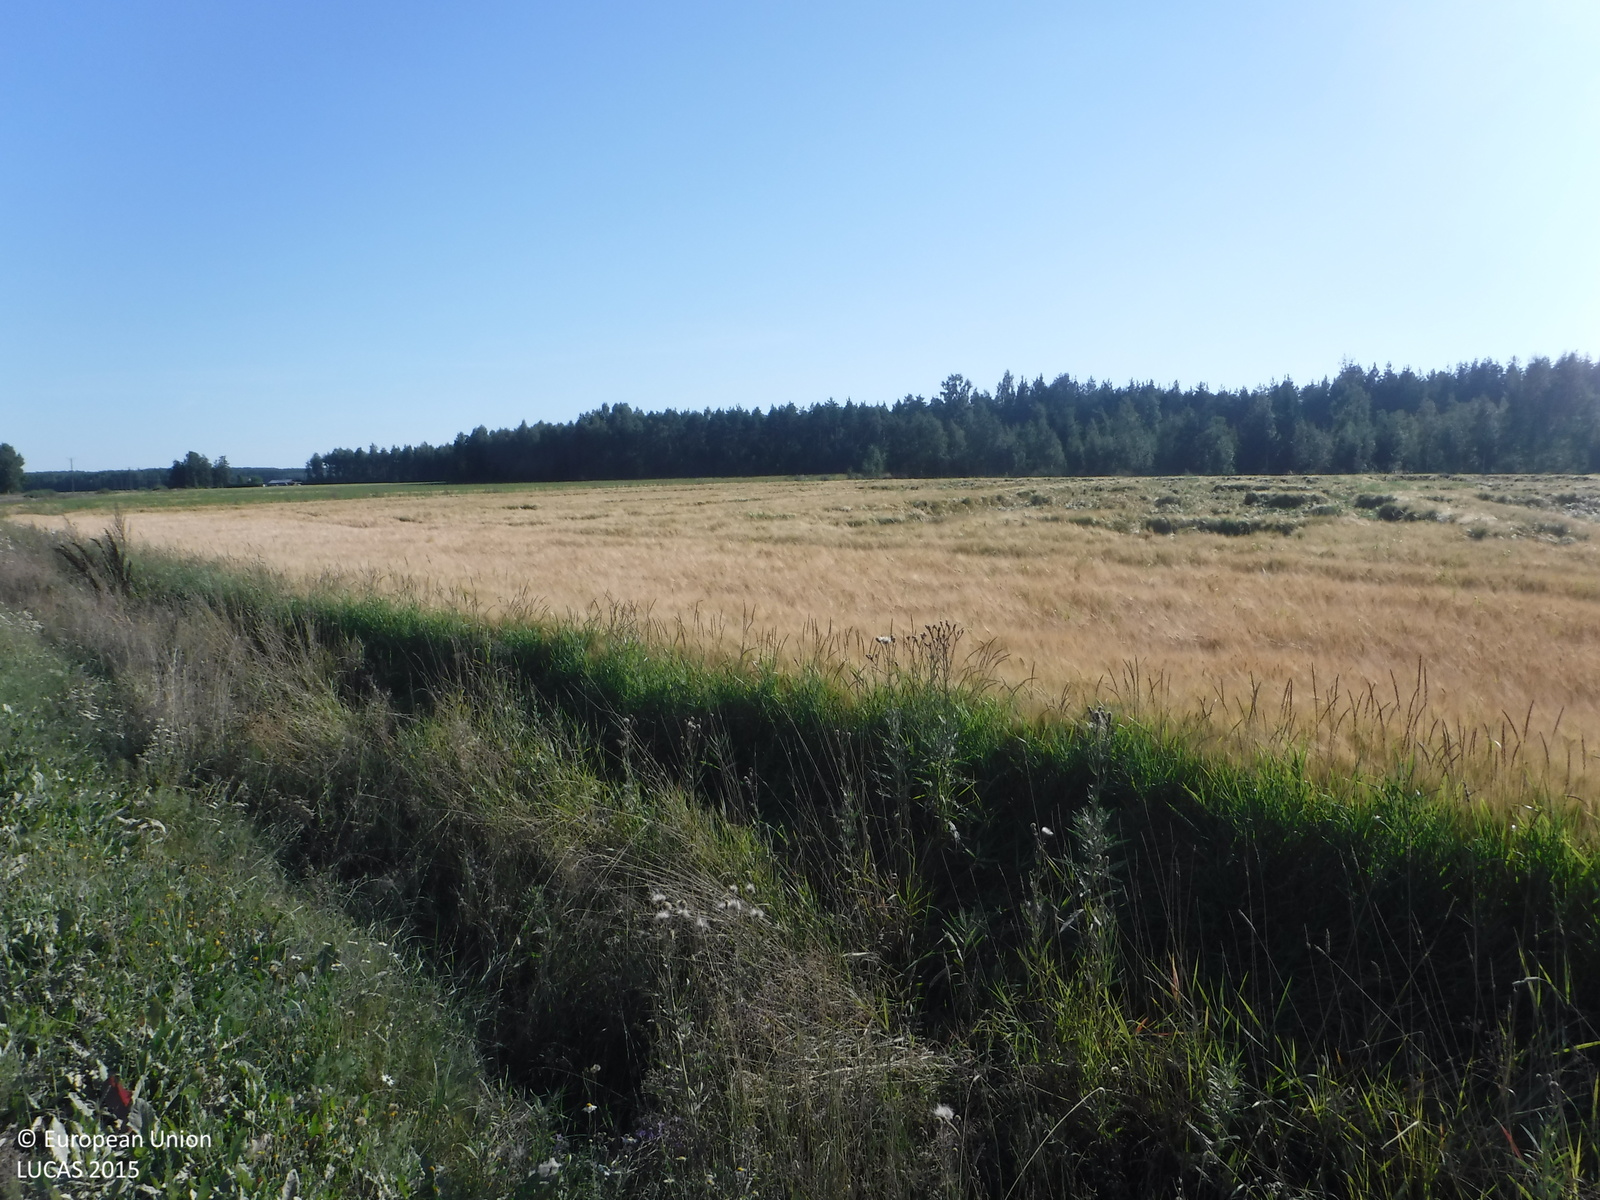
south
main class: Cropland
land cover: Barley
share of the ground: > 75 %
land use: Agriculture (excluding fallow land and kitchen gardens)
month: August
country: FI
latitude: 61.2001
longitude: 22.6278
